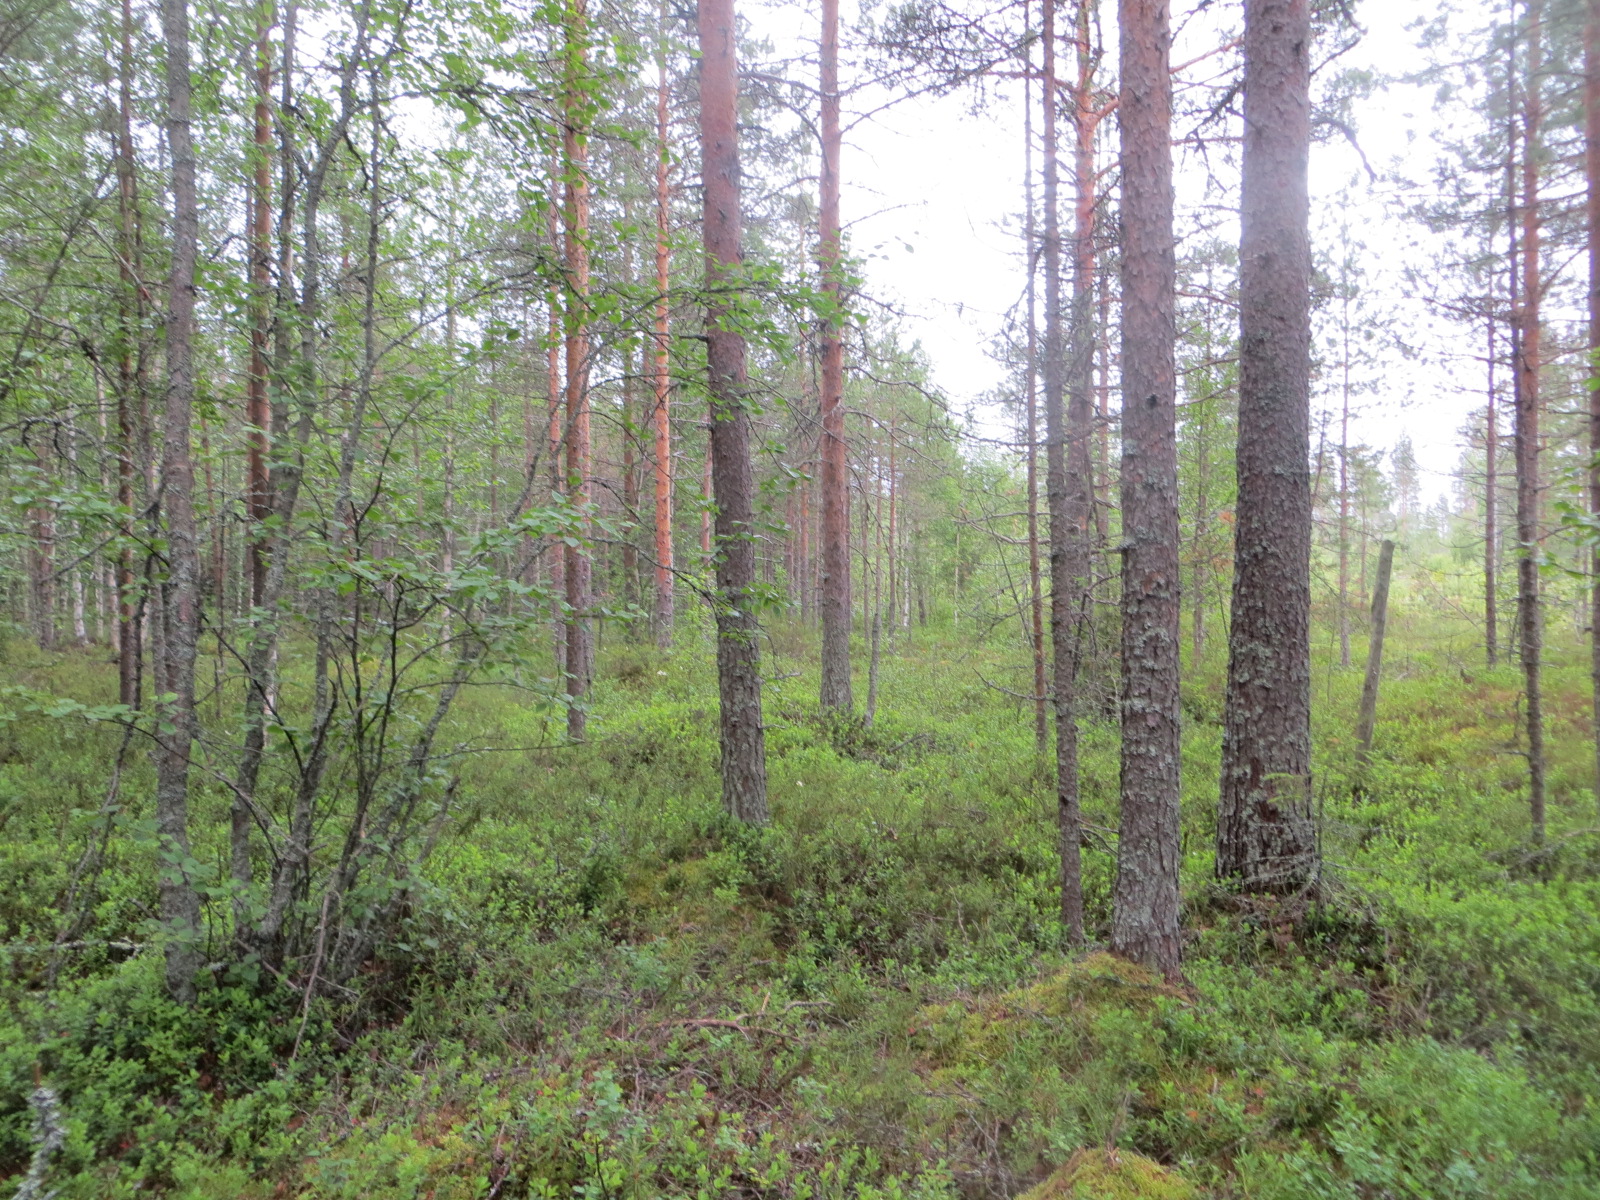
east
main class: Woodland
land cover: Pine dominated coniferous woodland
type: boreal forest
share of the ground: 50 - 75 %
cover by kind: coniferous forest trees 65 %, shrubs 30 %, broadleaved forest trees 5 %
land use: Forestry
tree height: > 5 m
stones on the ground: < 10 %
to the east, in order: Pine dominated coniferous woodland; Other mixed woodland; Ditches and canals; Other mixed woodland; Ditches and canals; Other mixed woodland; Ditches and canals; Other mixed woodland; Ditches and canals; Broadleaved woodland; Ditches and canals; Broadleaved woodland; Ditches and canals; Broadleaved woodland; Ditches and canals; Broadleaved woodland; Ditches and canals; Broadleaved woodland; Ditches and canals; Broadleaved woodland; Ditches and canals; Broadleaved woodland; Ditches and canals; Broadleaved woodland; Ditches and canals; Broadleaved woodland; Ditches and canals; Broadleaved woodland; Ditches and canals; Broadleaved woodland; Ditches and canals; Broadleaved woodland; Ditches and canals; Broadleaved woodland
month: July
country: FI
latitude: 65.6383
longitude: 25.3902
